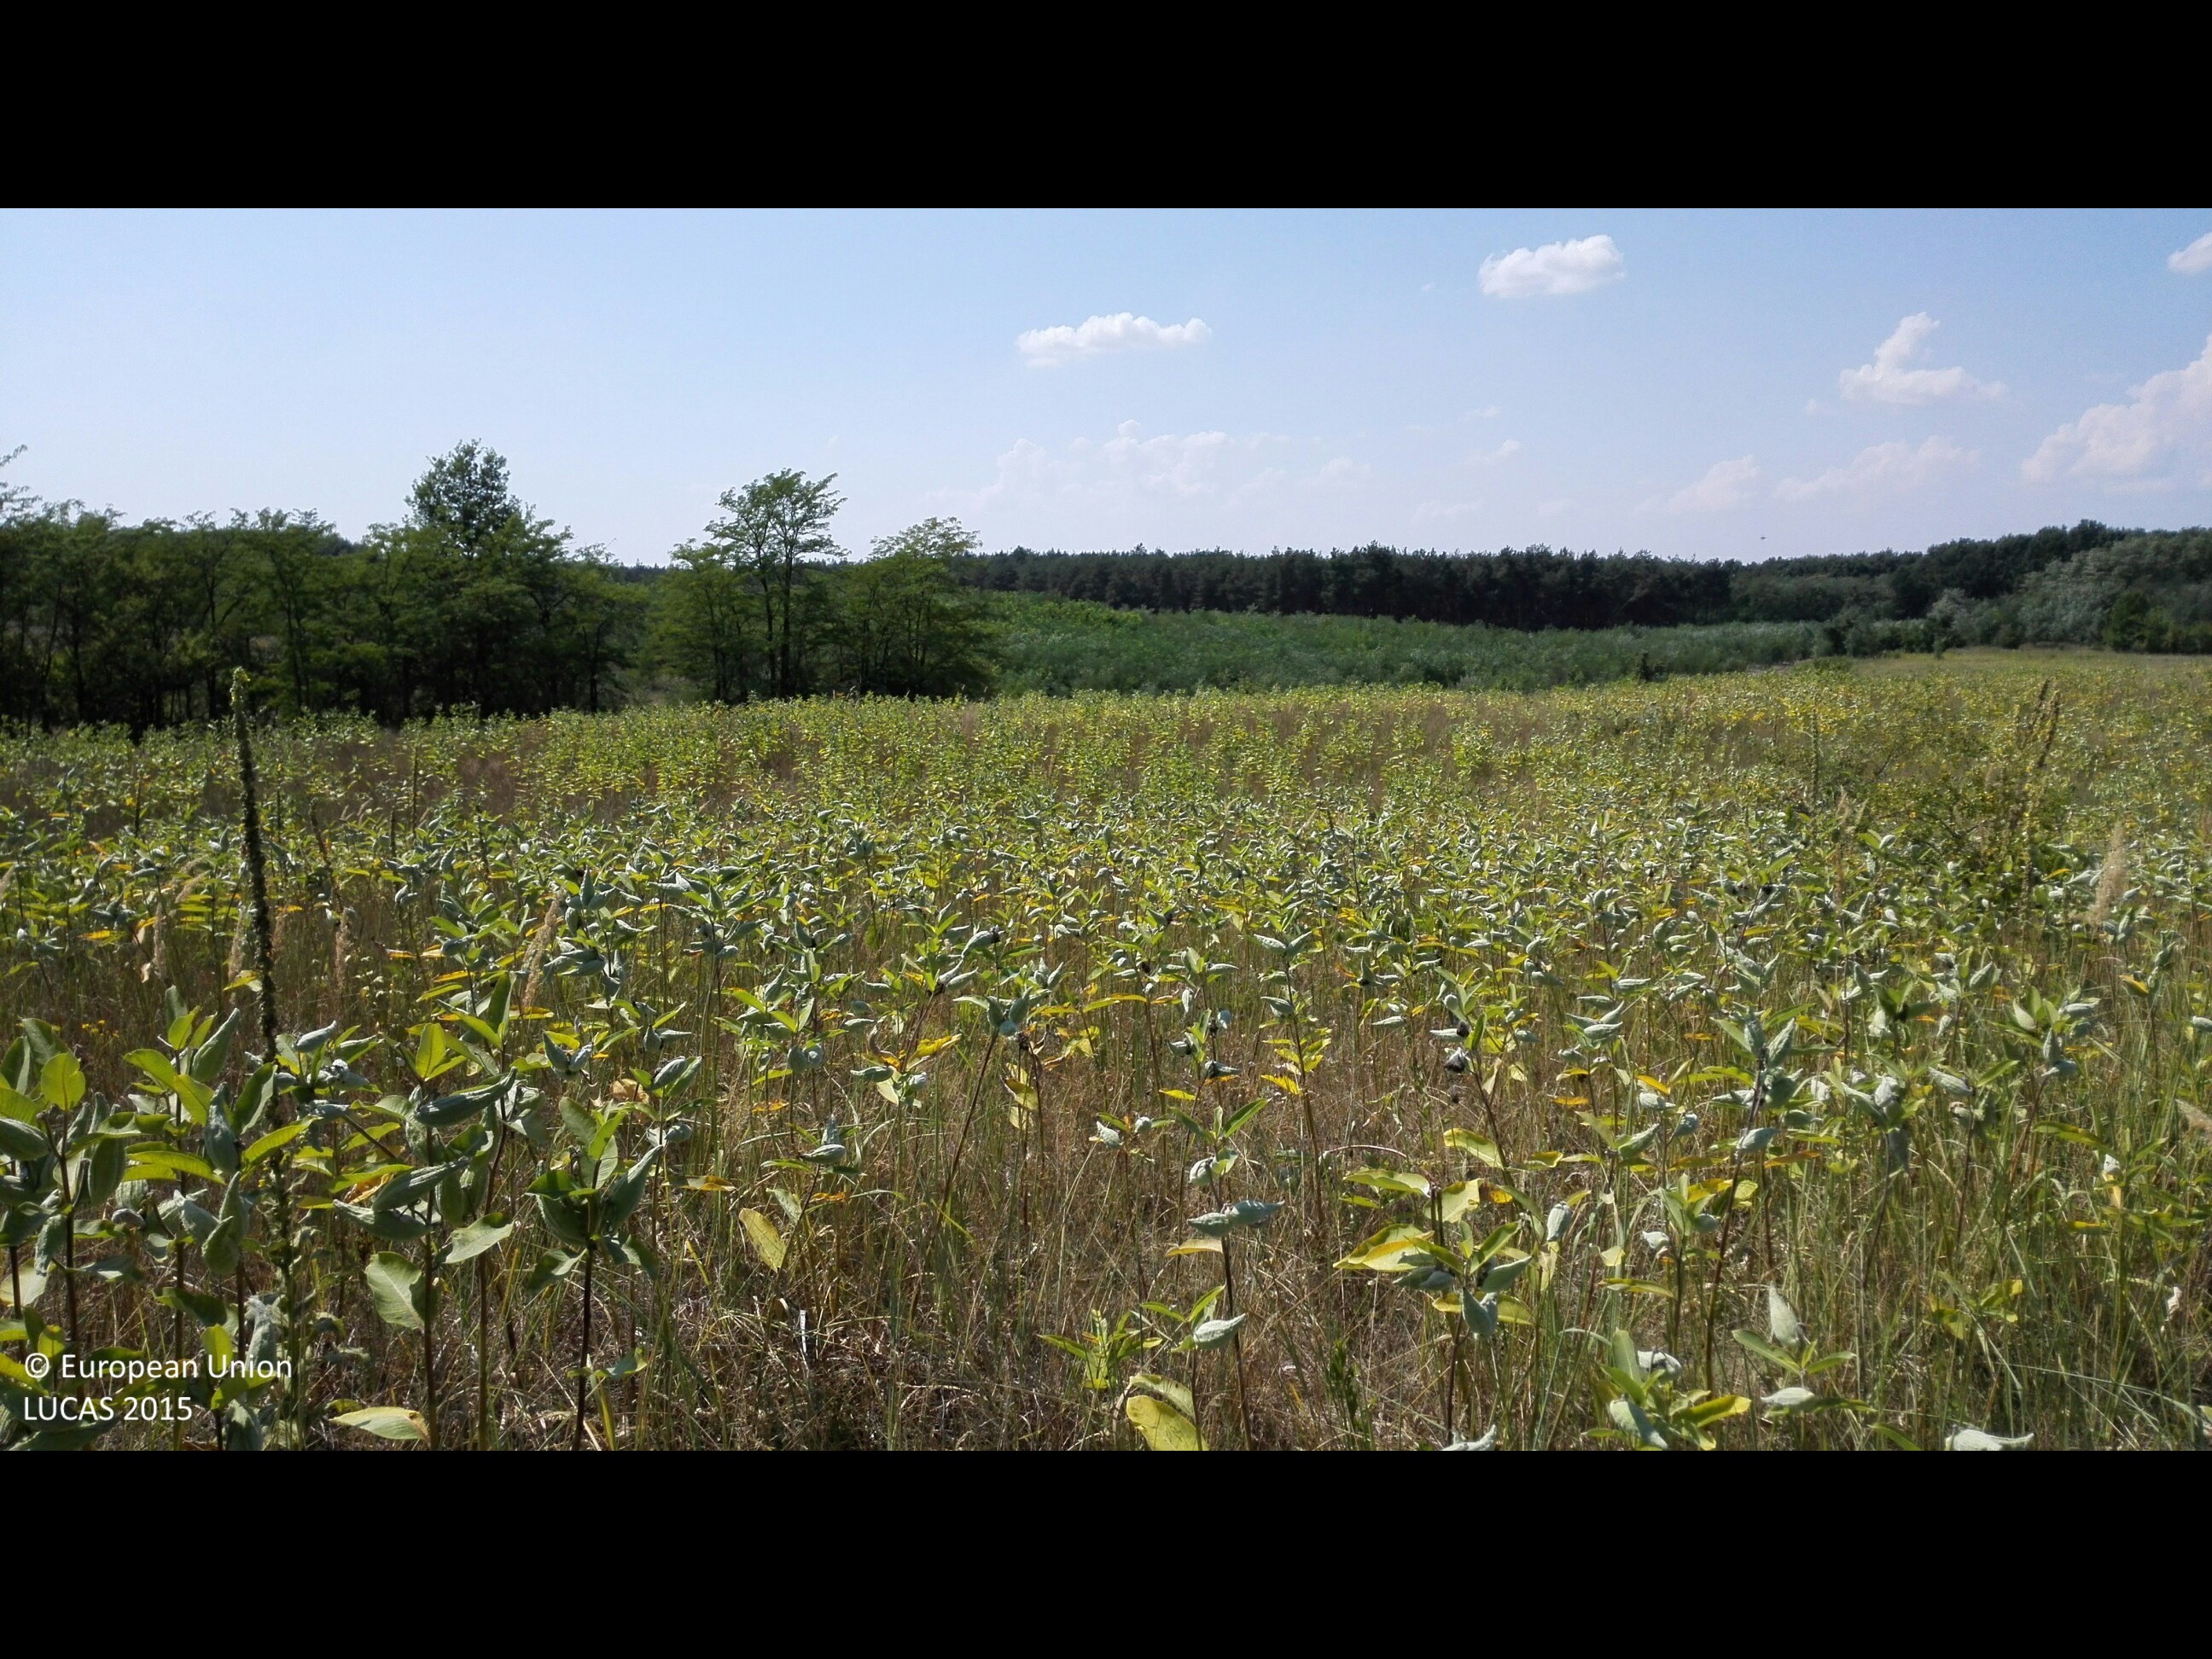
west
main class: Grassland
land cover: Grassland with sparse tree/shrub cover
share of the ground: > 75 %
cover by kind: herbaceous plants 90 %, broadleaved forest trees 5 %, shrubs 5 %
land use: Semi-natural and natural areas not in use
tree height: < 5 m
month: August
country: HU
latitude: 47.4413
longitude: 21.9700
